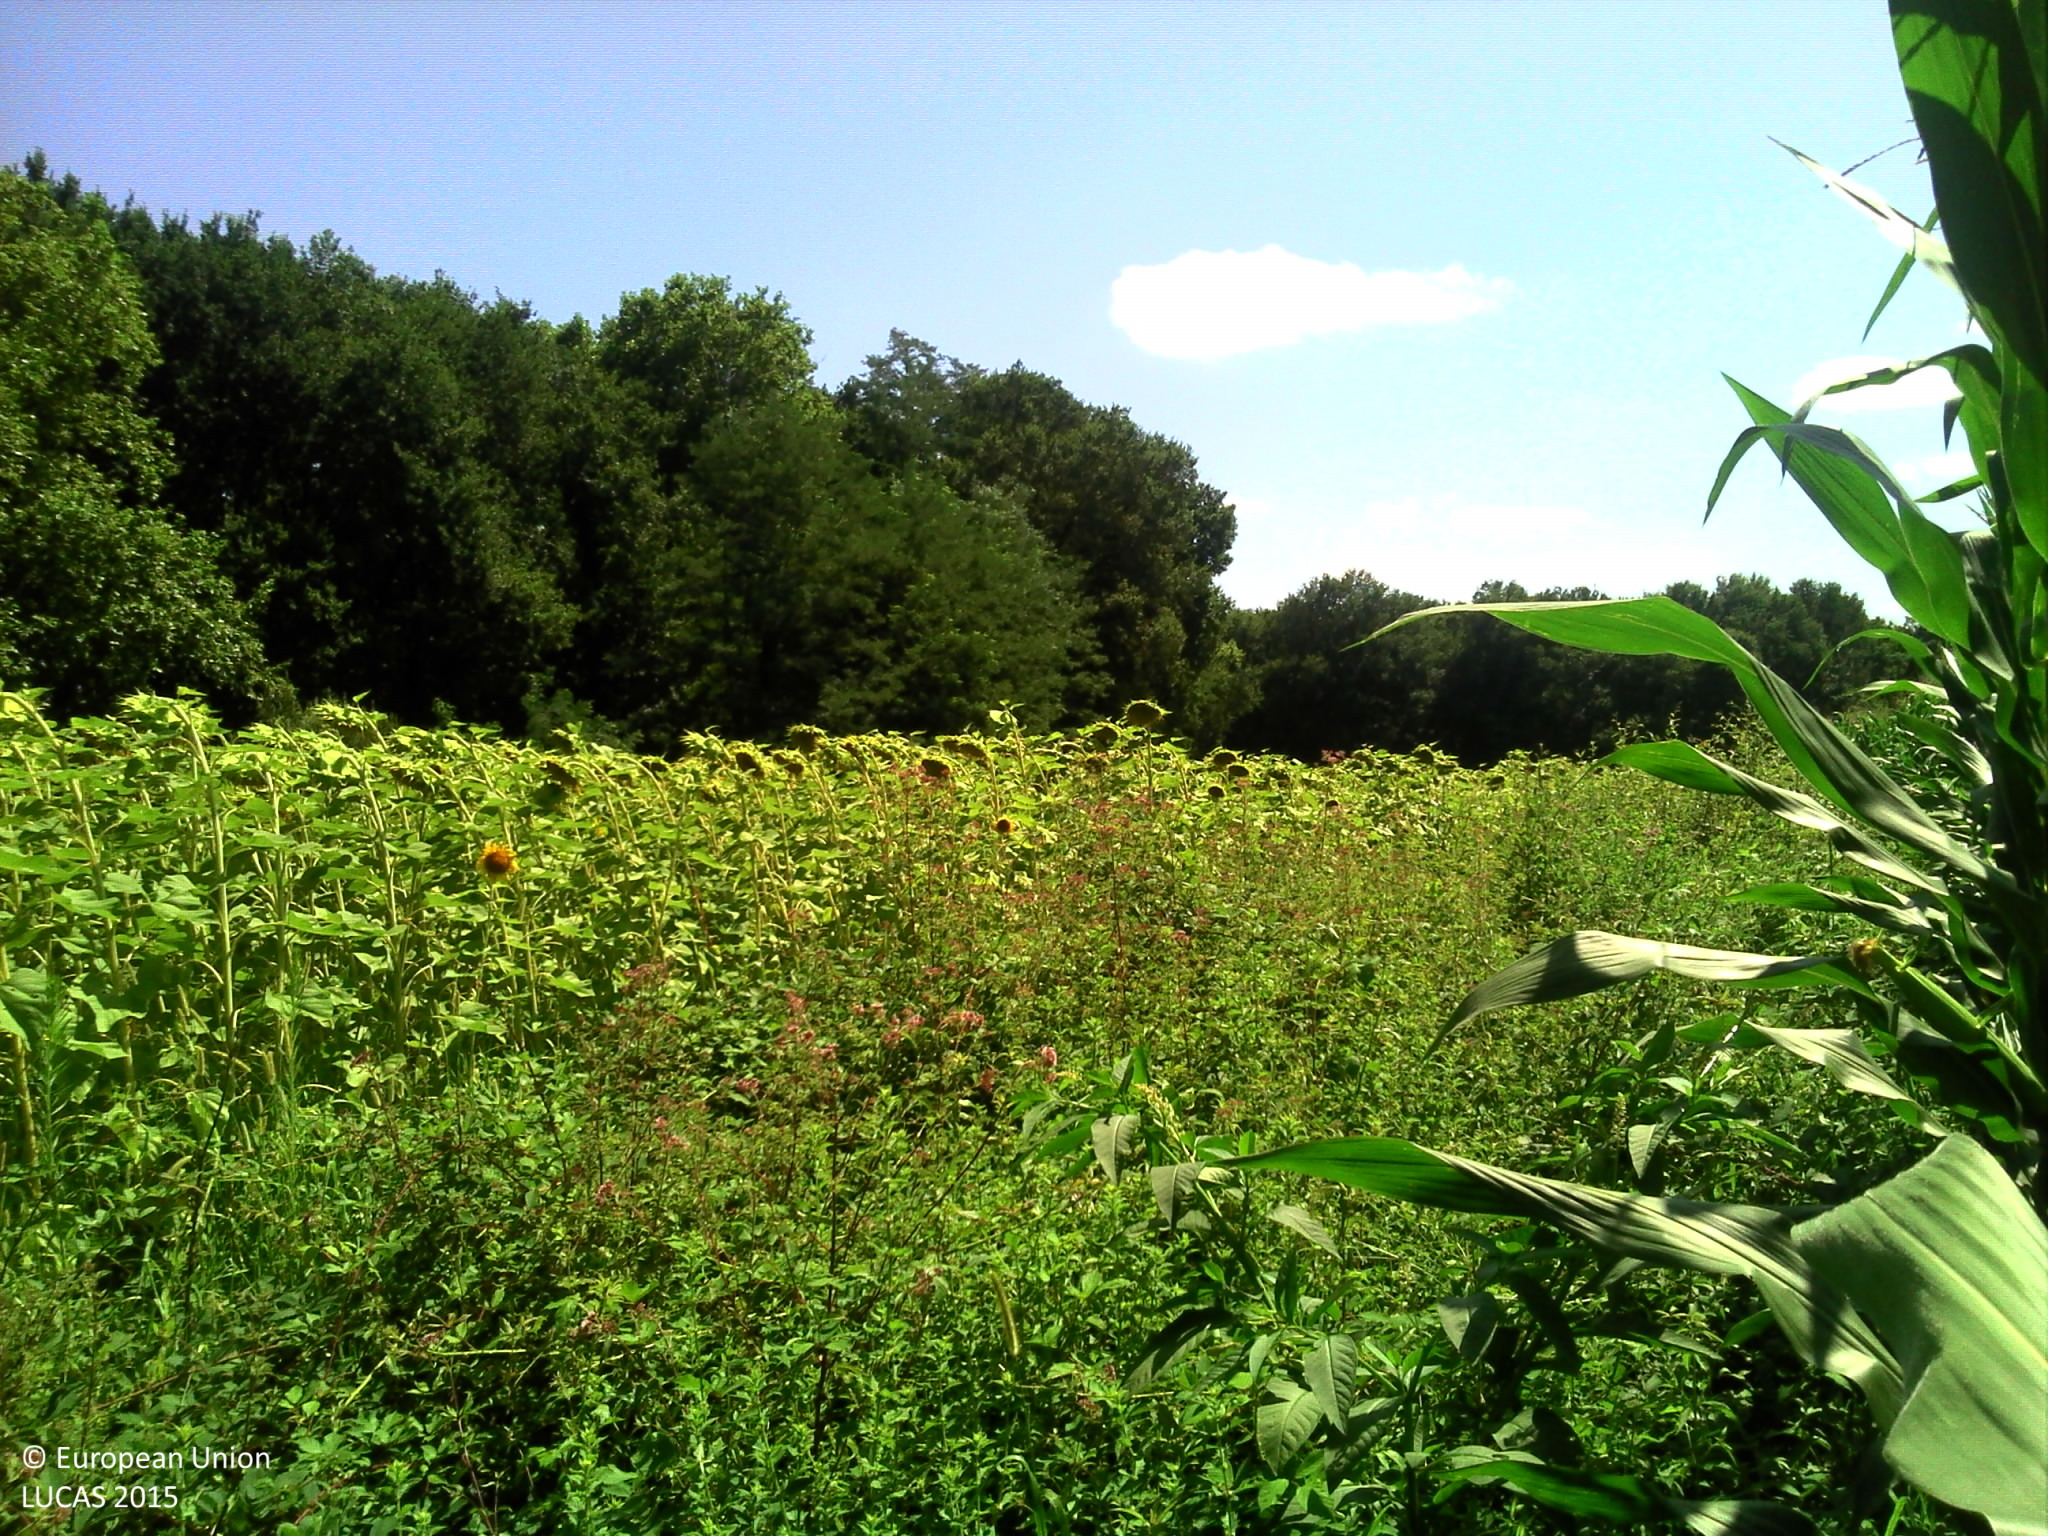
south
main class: Cropland
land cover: Maize
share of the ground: > 75 %
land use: Agriculture (excluding fallow land and kitchen gardens)
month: July
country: FR
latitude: 43.5662
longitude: -1.1461
